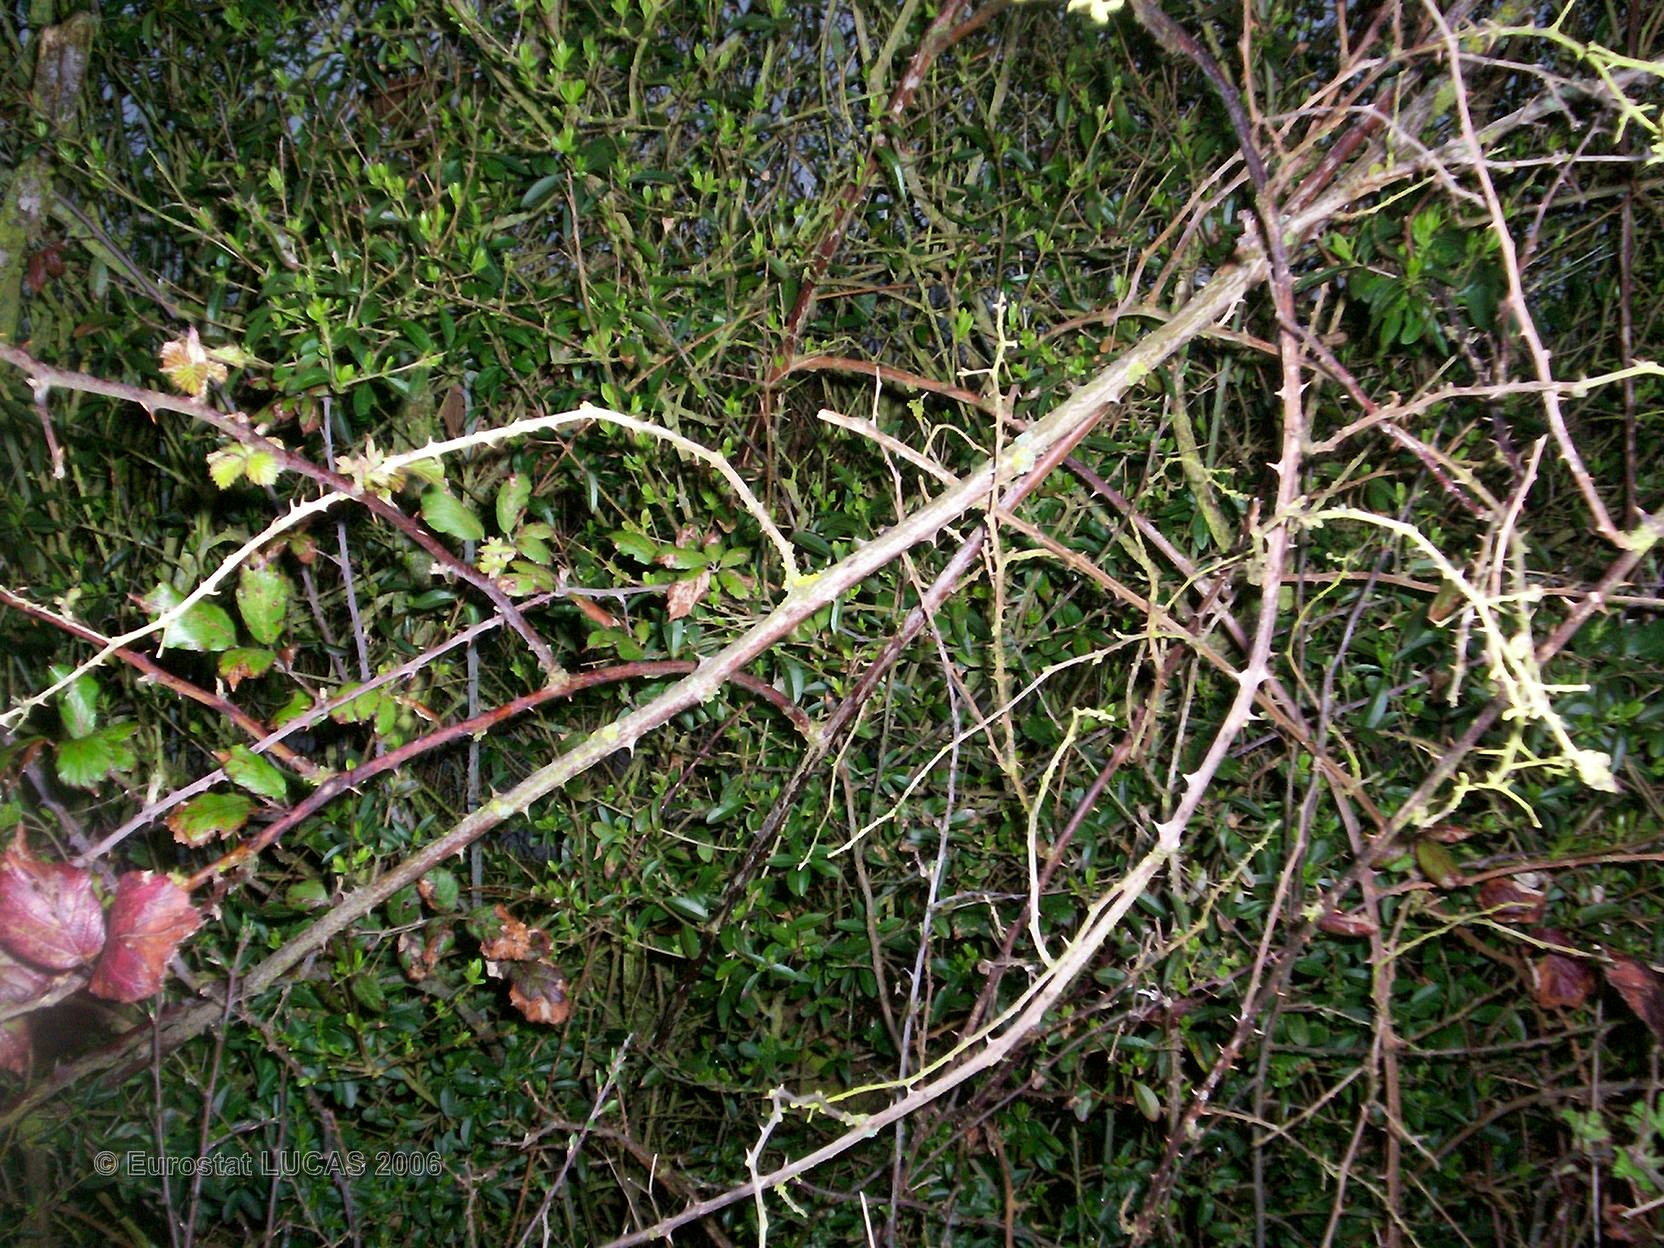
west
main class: Grassland
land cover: Grassland without tree/shrub cover
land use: Agriculture (excluding fallow land and kitchen gardens)
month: April
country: FR
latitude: 48.4656
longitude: 0.3034
